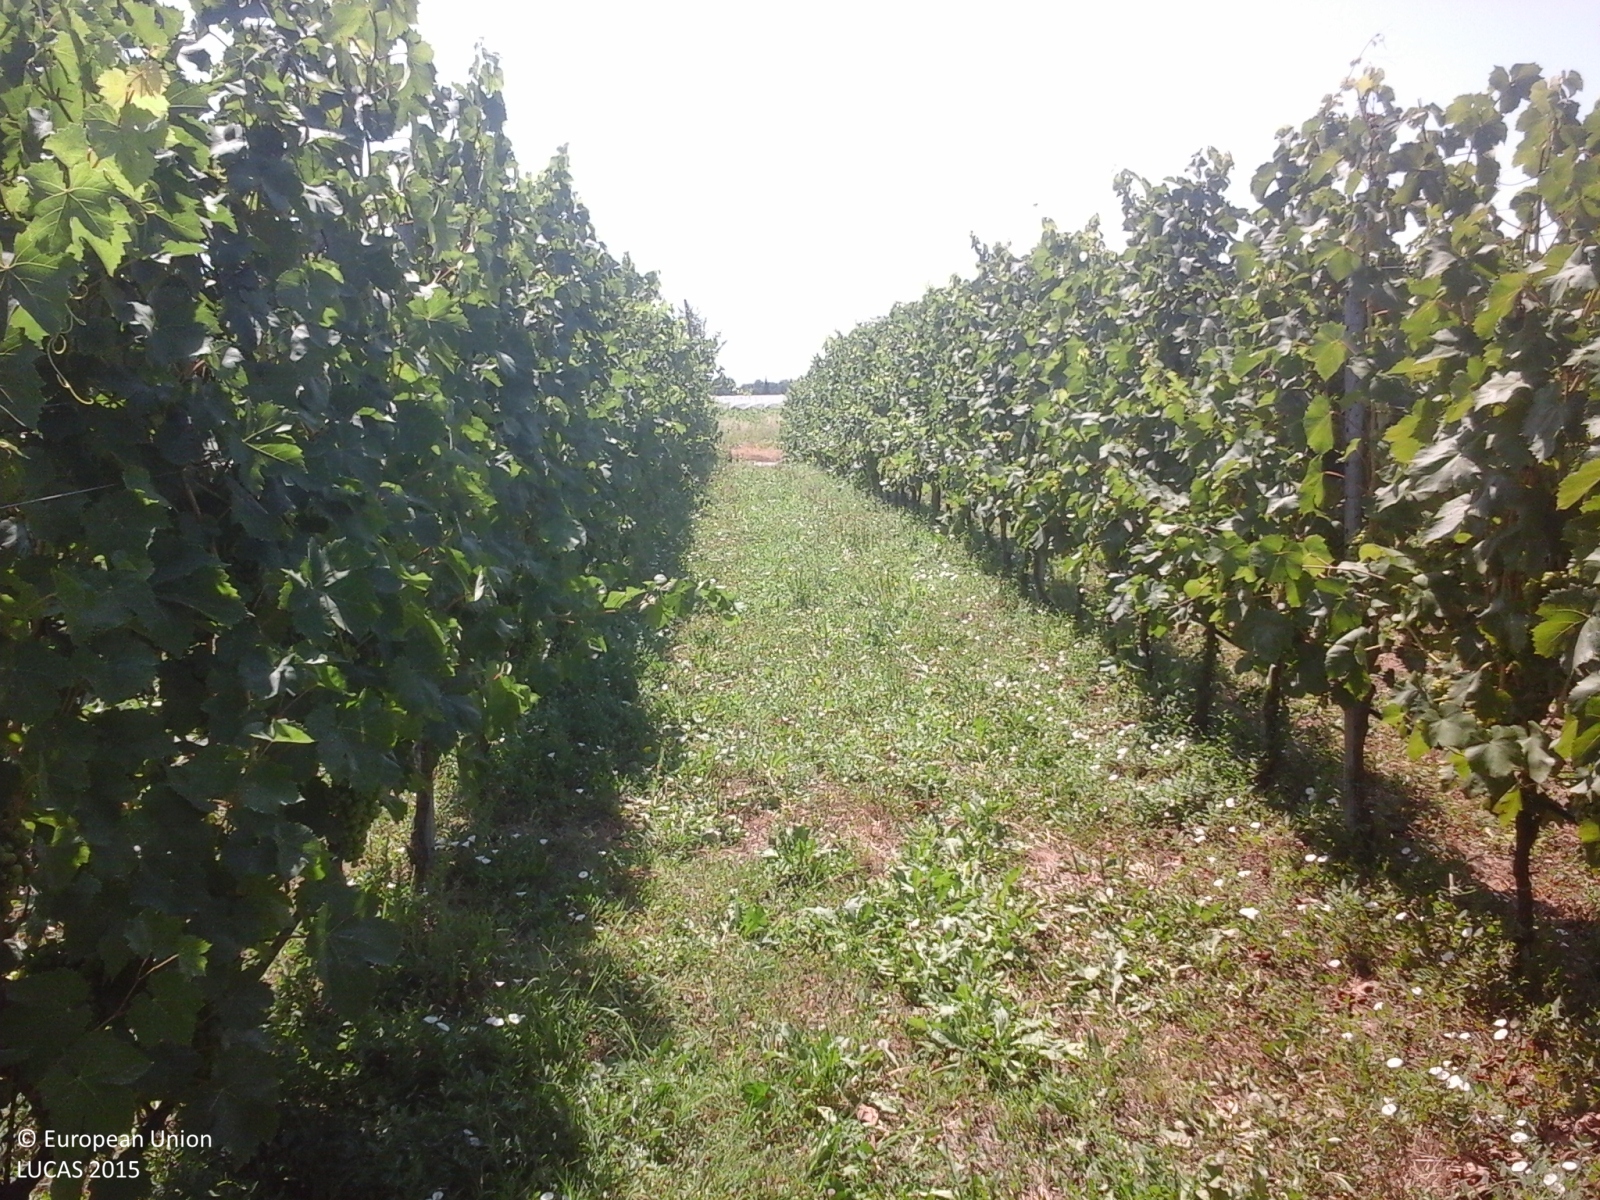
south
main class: Cropland
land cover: Vineyards
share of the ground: 25 - 50 %
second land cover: Grassland without tree/shrub cover
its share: > 75 %
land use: Agriculture (excluding fallow land and kitchen gardens)
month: July
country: IT
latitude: 45.4485
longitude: 10.6254
